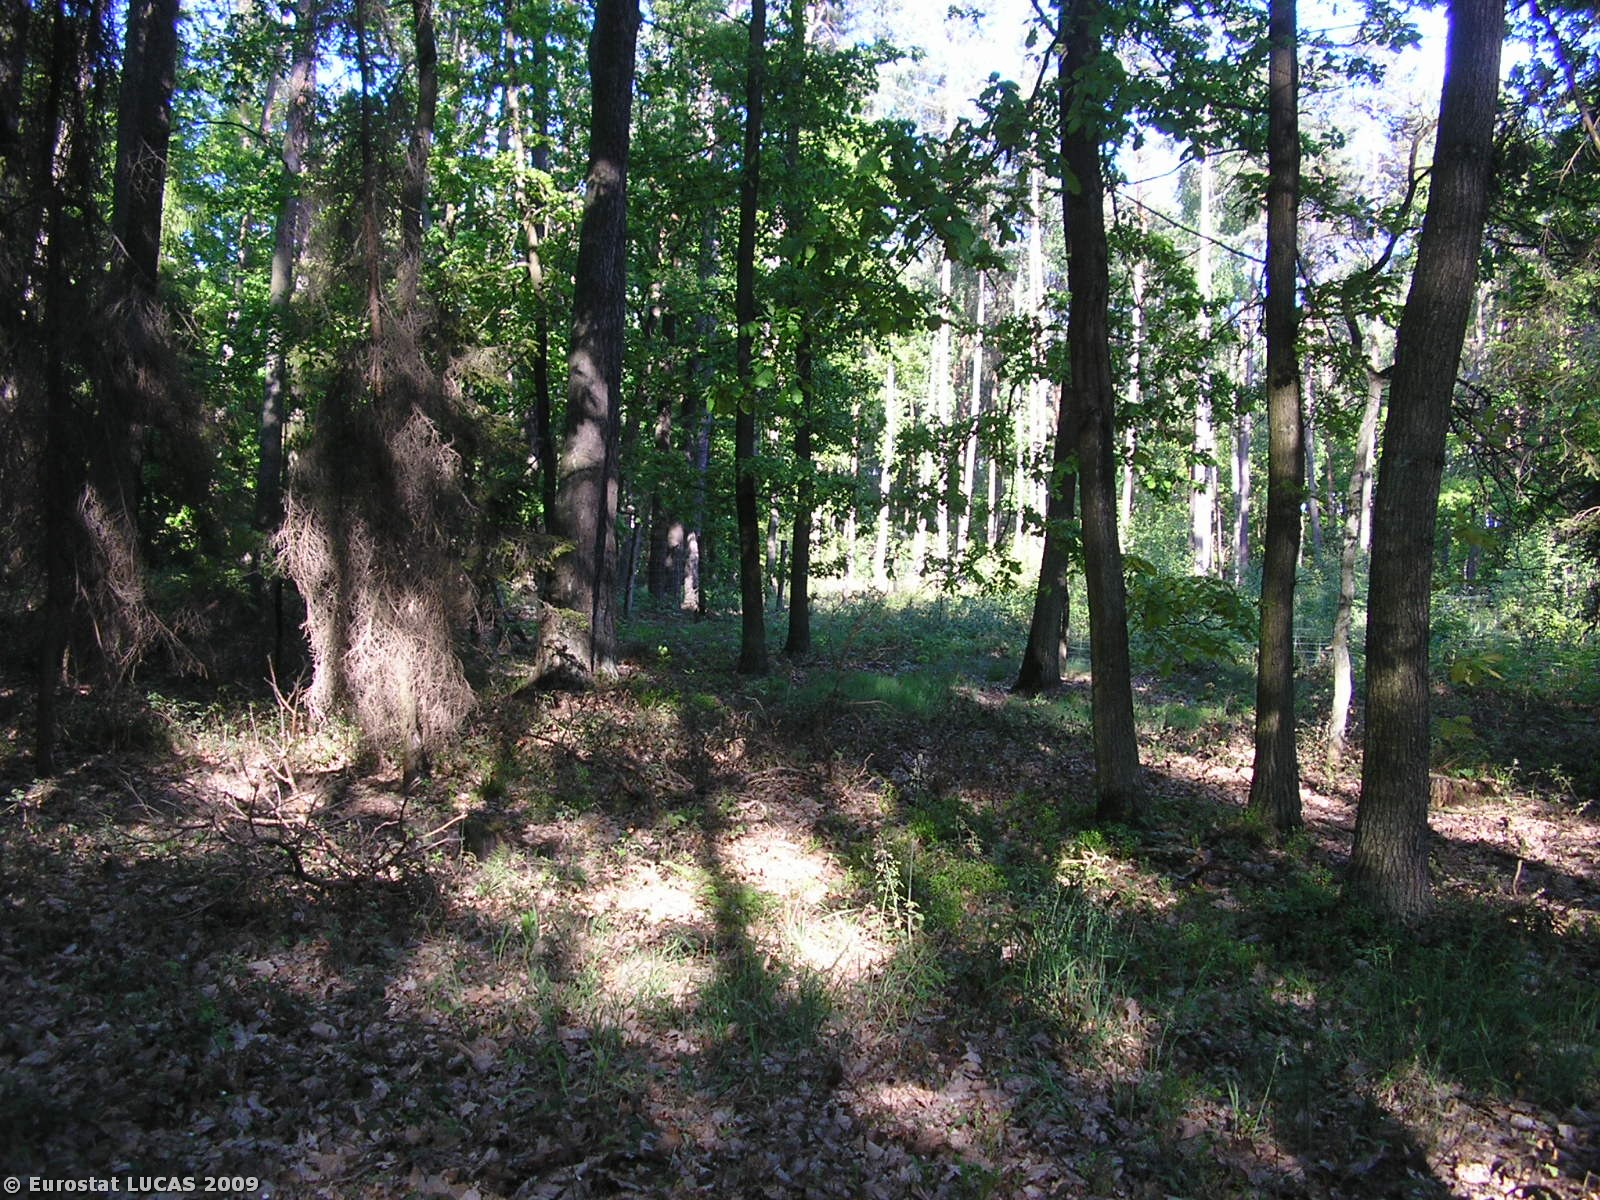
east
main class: Woodland
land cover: Mixed woodland
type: hemiboreal forest and nemoral coniferous forest and mixed broadleaved-coniferous forest
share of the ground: > 75 %
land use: Forestry
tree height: > 5 m
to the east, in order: Mixed woodland; Paved roads, cycling and walking lanes; Mixed woodland
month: May
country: PL
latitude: 51.6292
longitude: 19.9863
